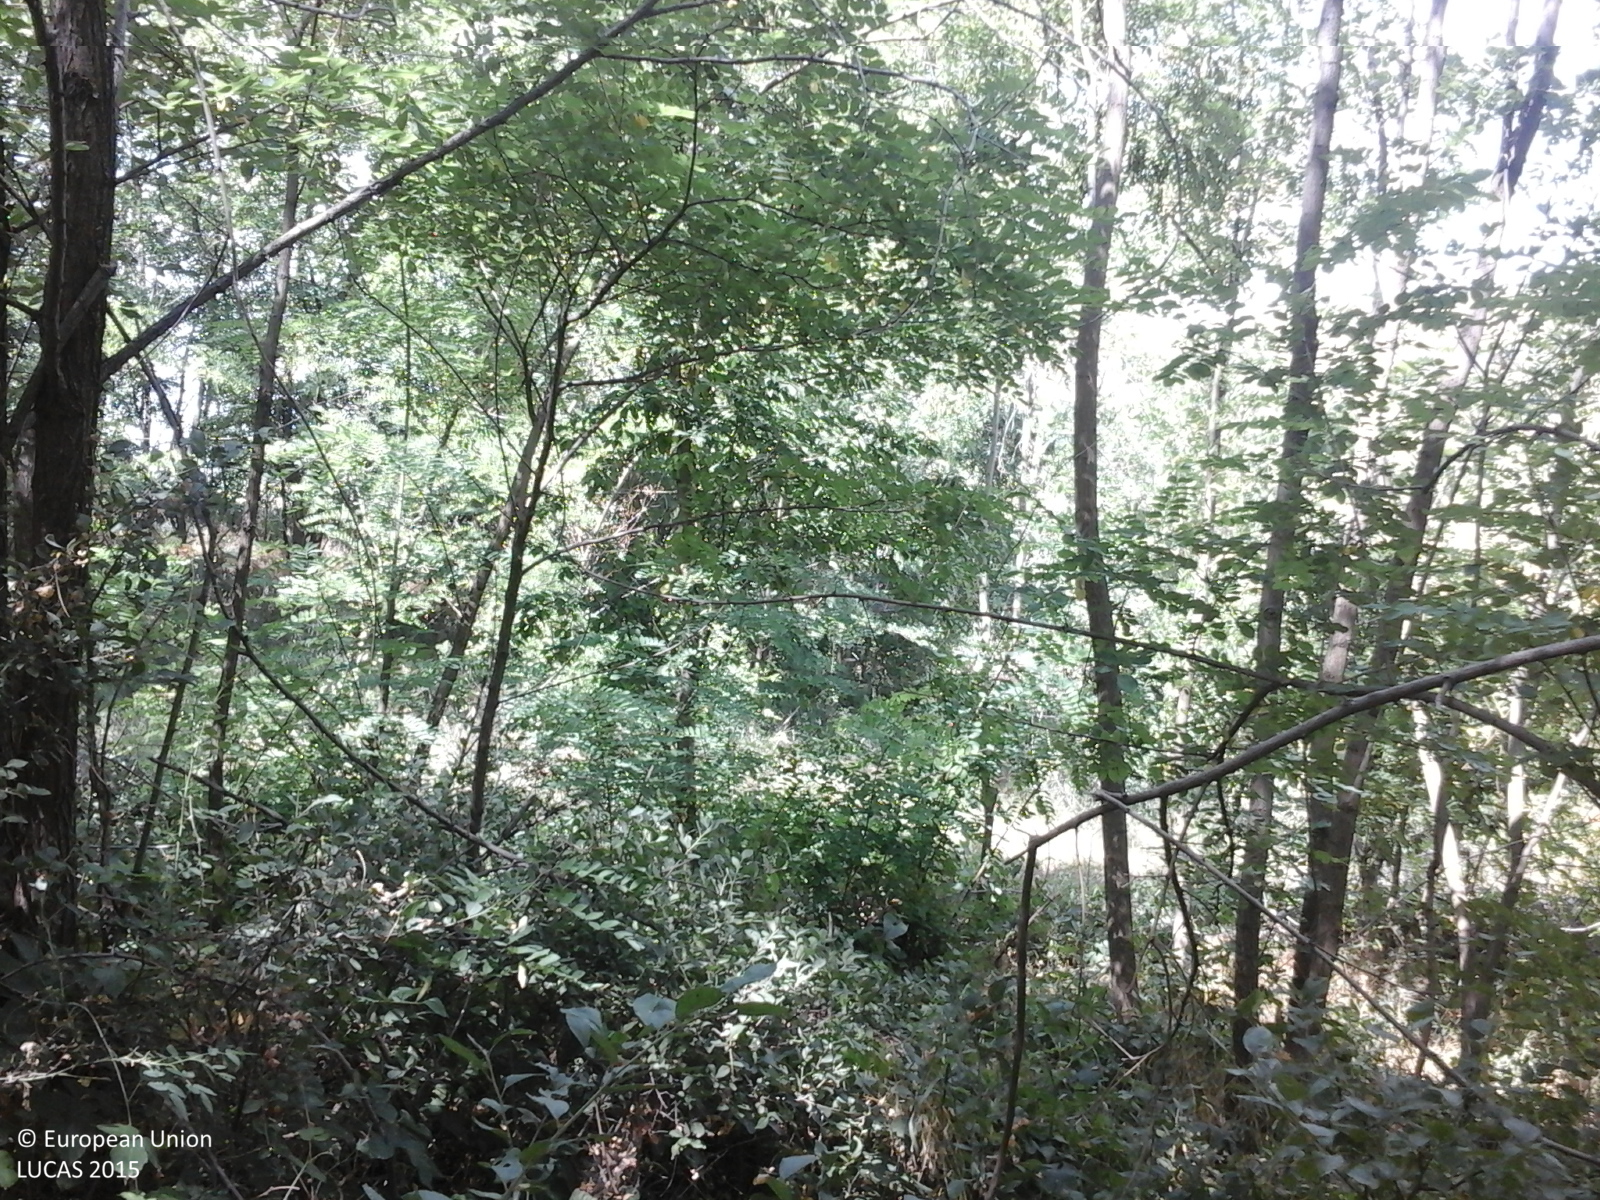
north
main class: Woodland
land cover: Broadleaved woodland
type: exotic forest
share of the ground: > 75 %
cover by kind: broadleaved forest trees 100 %
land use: Forestry
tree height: > 5 m
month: July
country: RO
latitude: 46.5420
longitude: 27.3322
